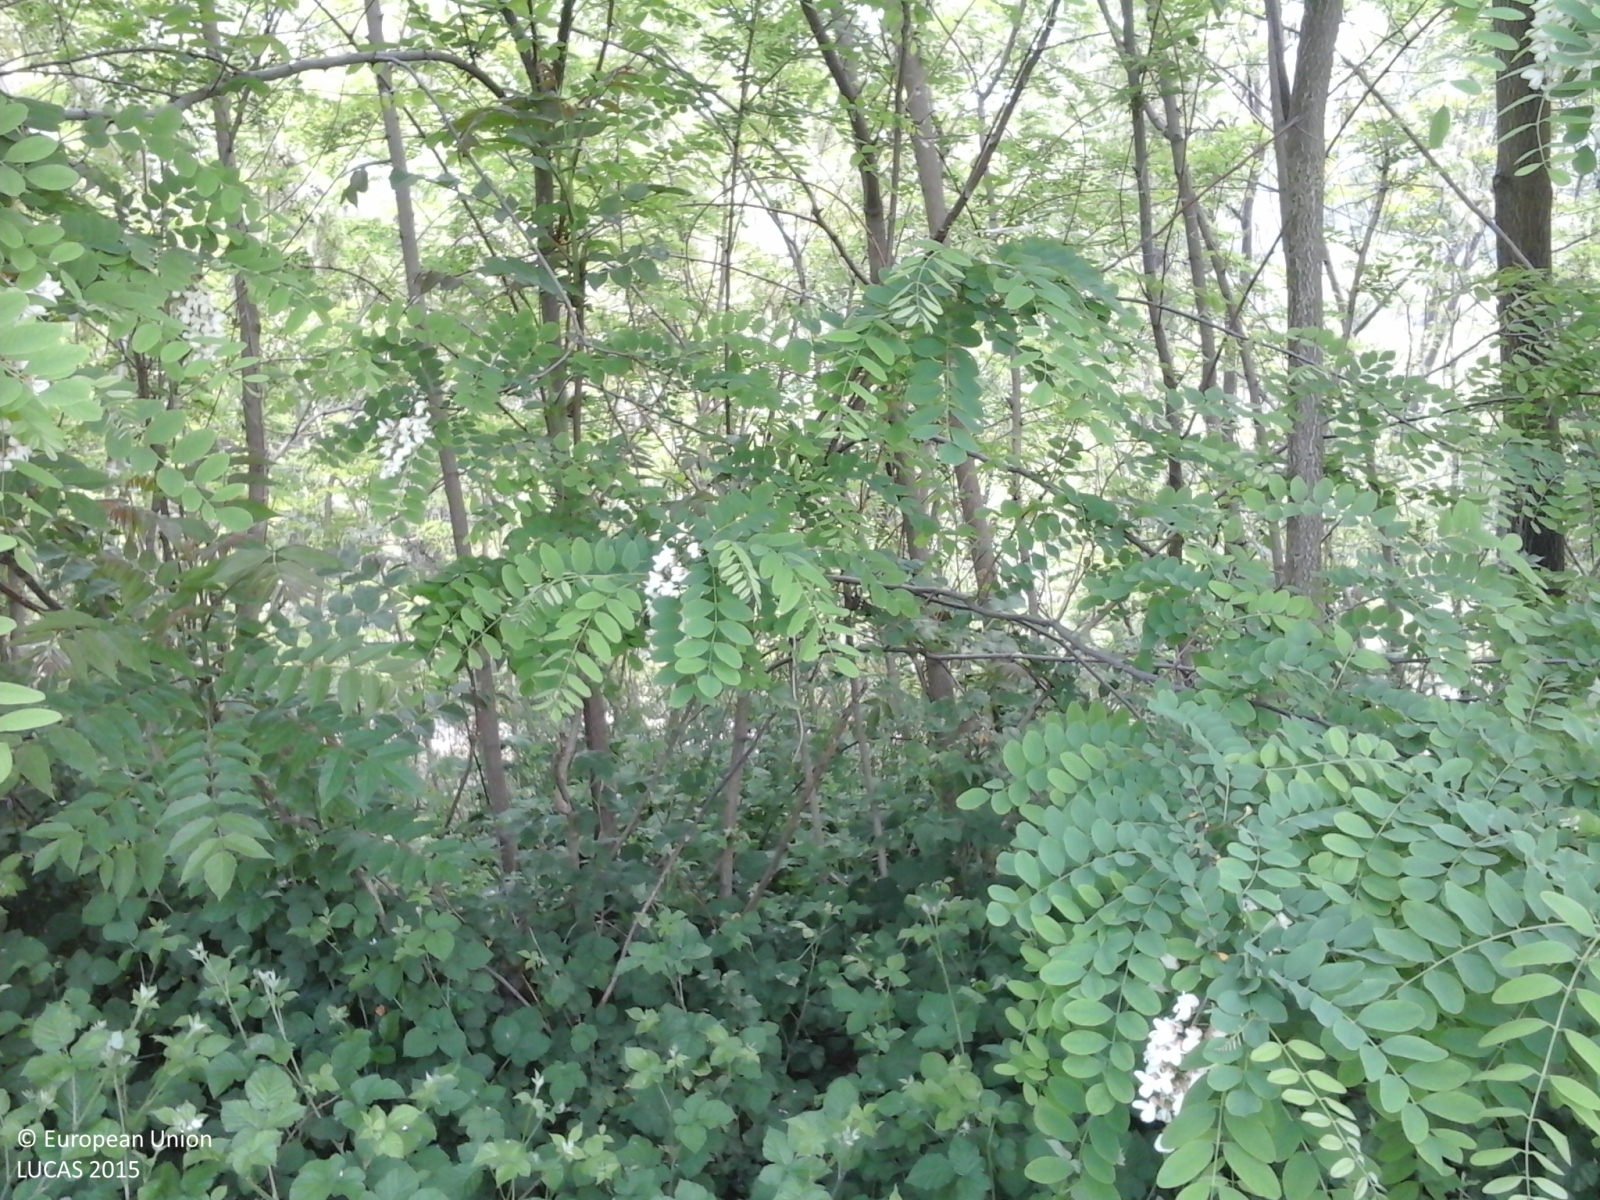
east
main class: Woodland
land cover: Broadleaved woodland
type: mesophytic deciduous forest
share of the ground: > 75 %
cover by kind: broadleaved forest trees 100 %
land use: Semi-natural and natural areas not in use
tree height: > 5 m
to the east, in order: Broadleaved woodland; Tracks; Broadleaved woodland; Inland fresh running water; Broadleaved woodland; Grassland without tree/shrub cover; Tracks; Electric lines; Grassland without tree/shrub cover; Broadleaved woodland; Tracks; Lucerne
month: May
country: IT
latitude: 44.4912
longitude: 10.8658
